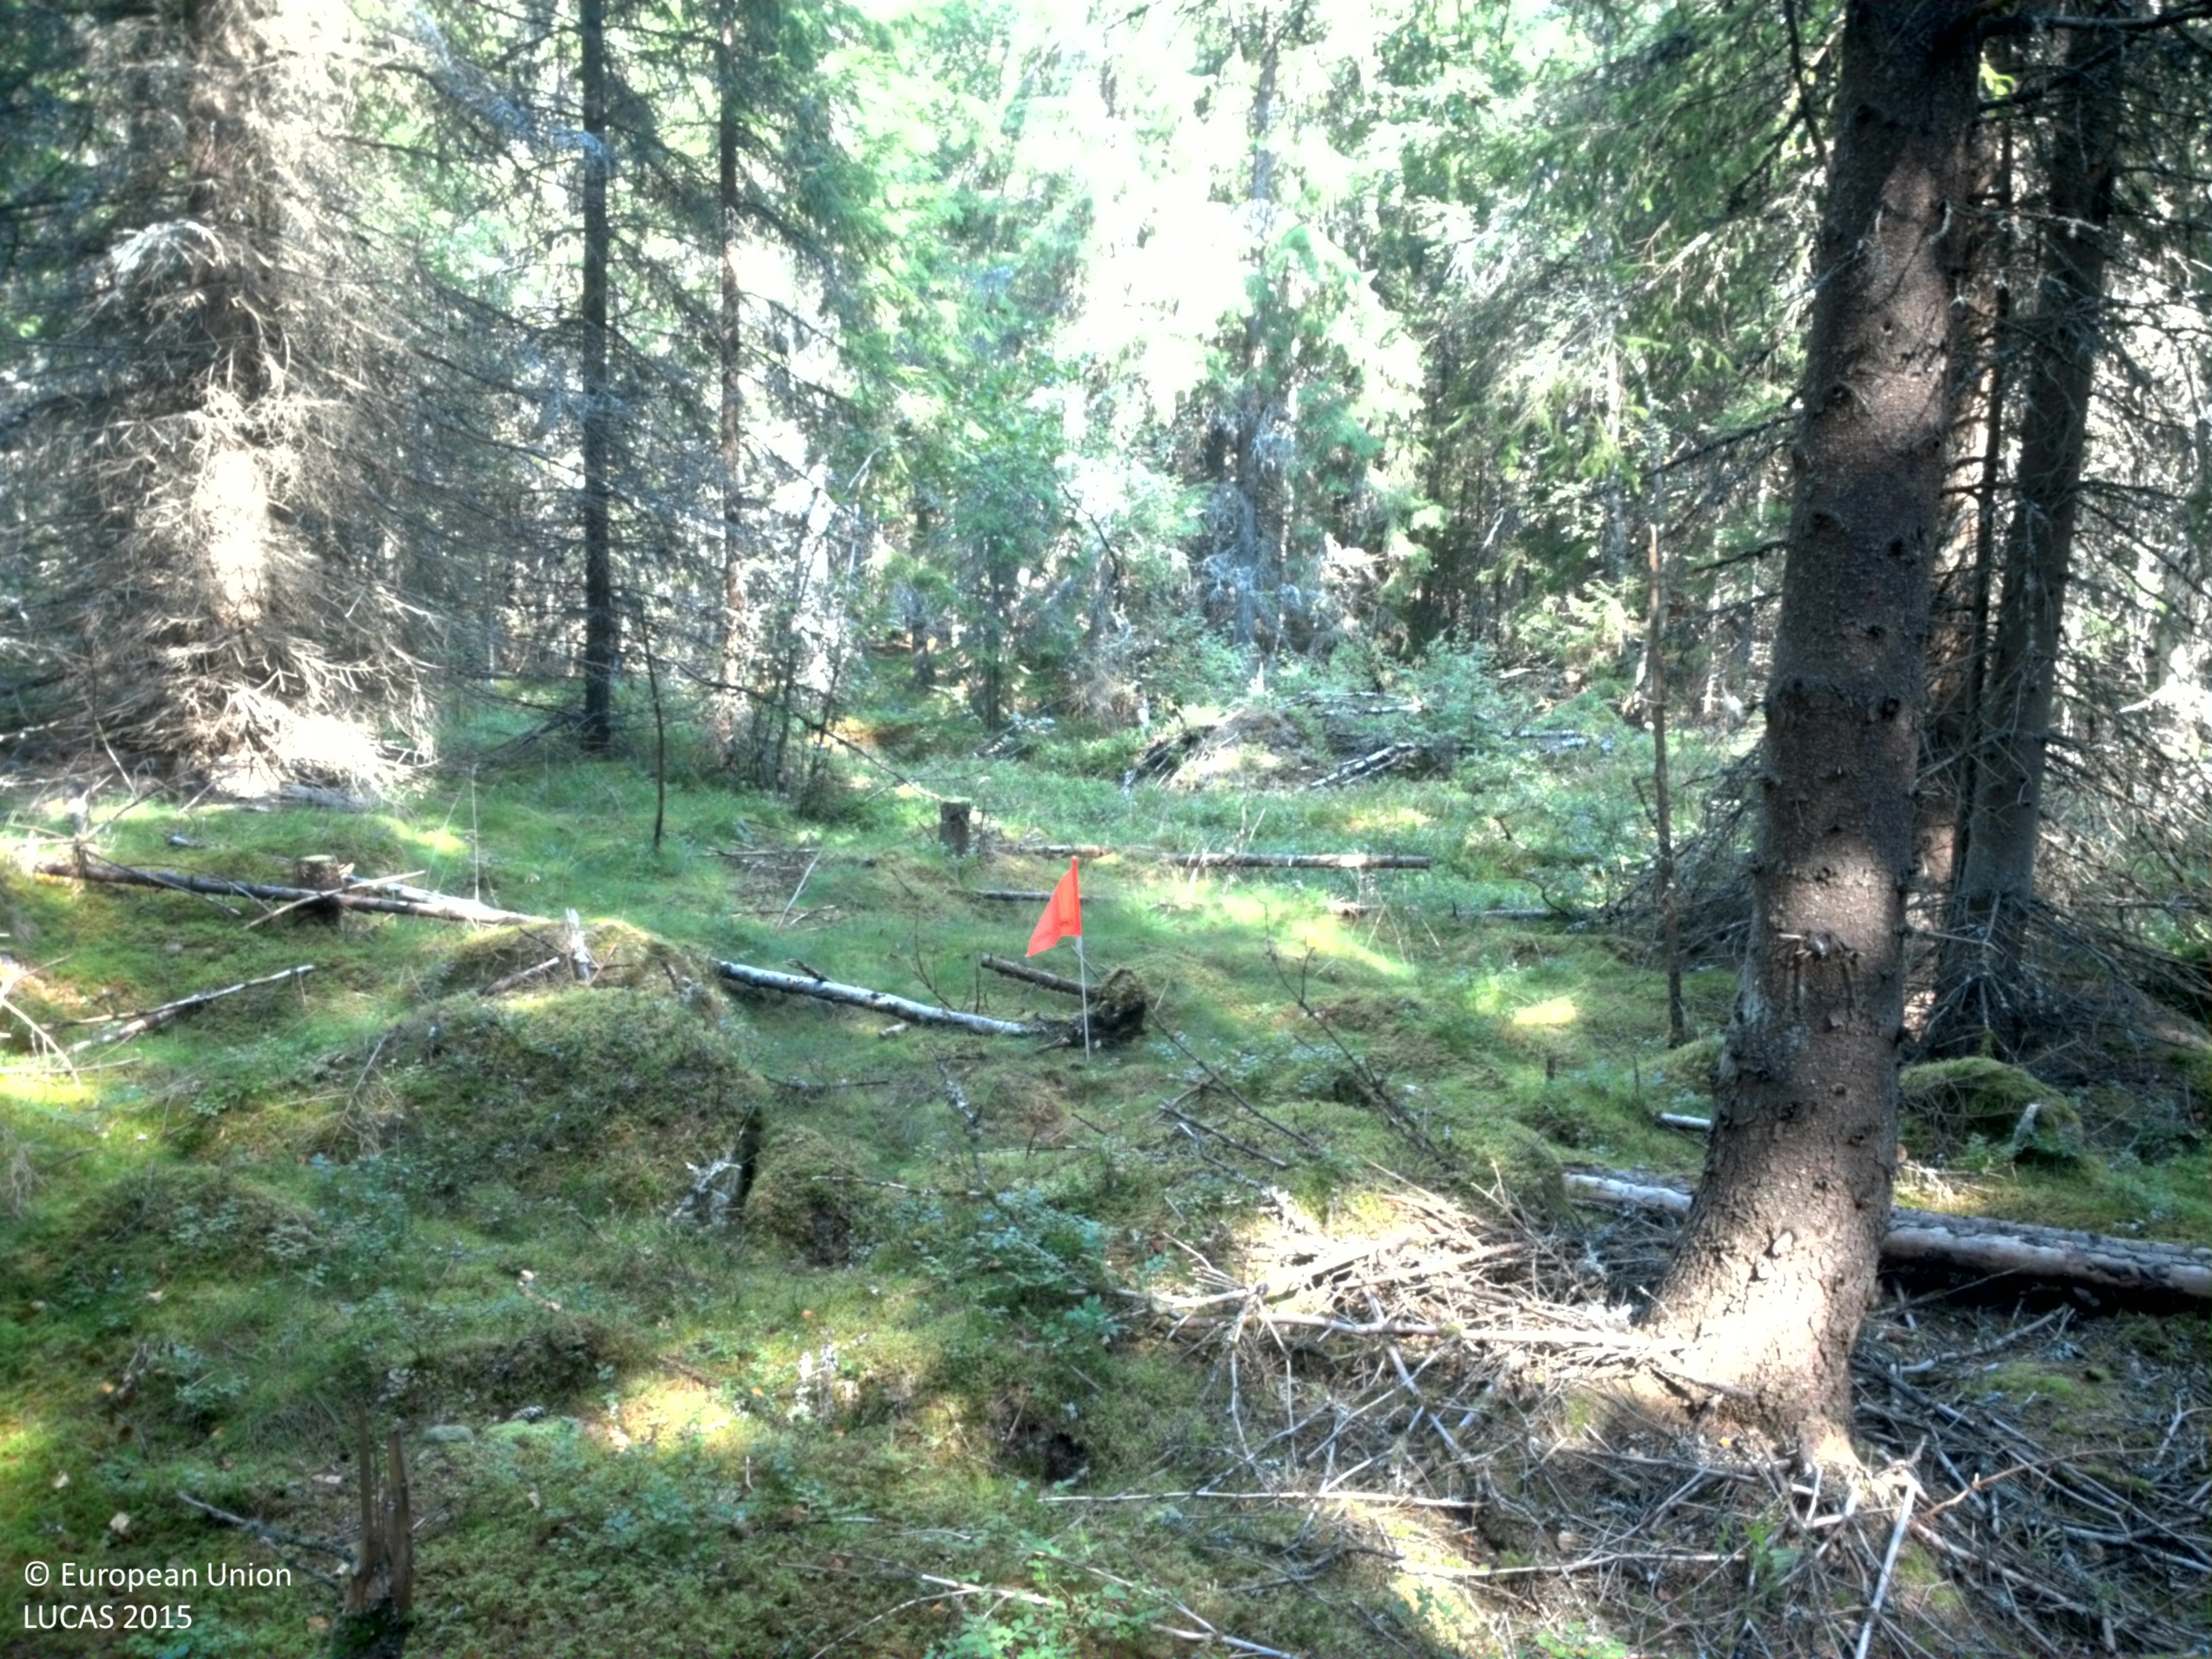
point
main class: Woodland
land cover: Spruce dominated coniferous woodland
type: boreal forest
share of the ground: > 75 %
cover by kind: coniferous forest trees 75 %, lichens and mosses 20 %, shrubs 5 %
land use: Forestry
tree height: > 5 m
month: August
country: SE
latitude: 57.9470
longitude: 13.8973
